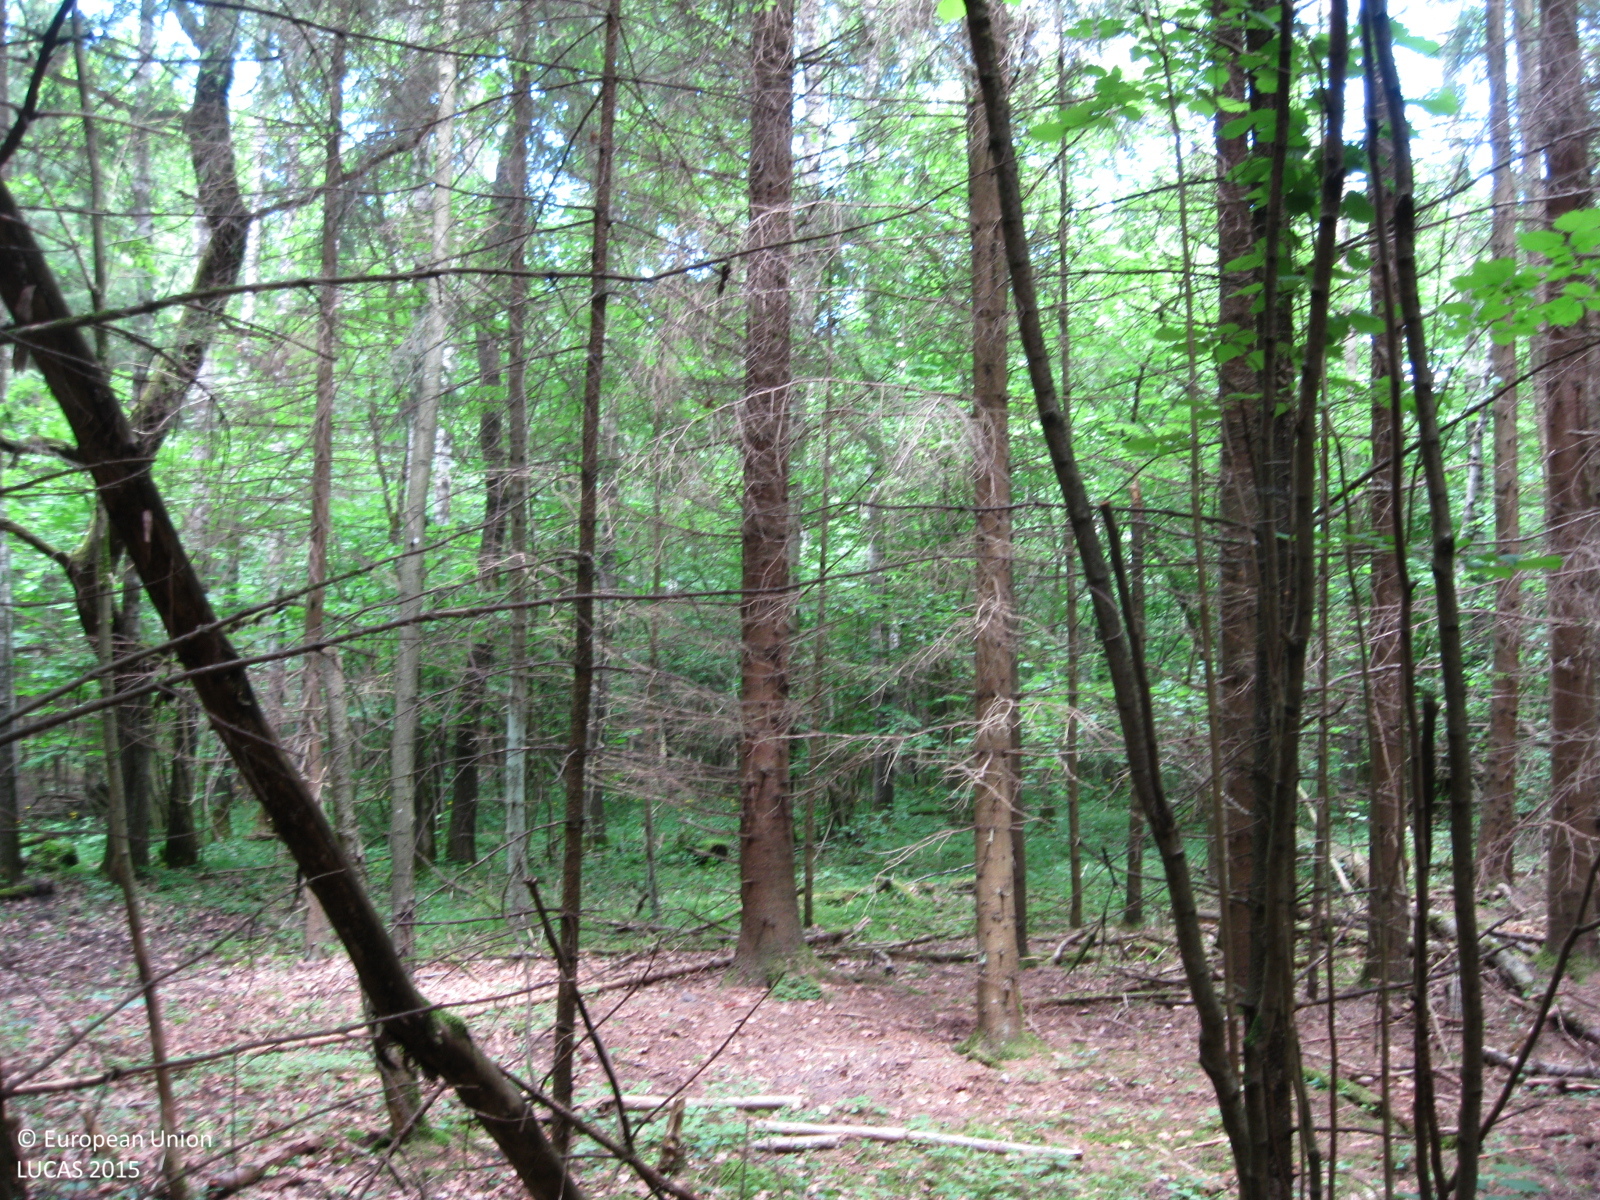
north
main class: Woodland
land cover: Spruce dominated coniferous woodland
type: hemiboreal forest and nemoral coniferous forest and mixed broadleaved-coniferous forest
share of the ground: > 75 %
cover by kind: coniferous forest trees 80 %, broadleaved forest trees 10 %, unconsolidated bare surface 10 %
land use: Forestry
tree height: > 5 m
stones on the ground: < 10 %
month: June
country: LT
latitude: 55.3828
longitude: 24.1240
